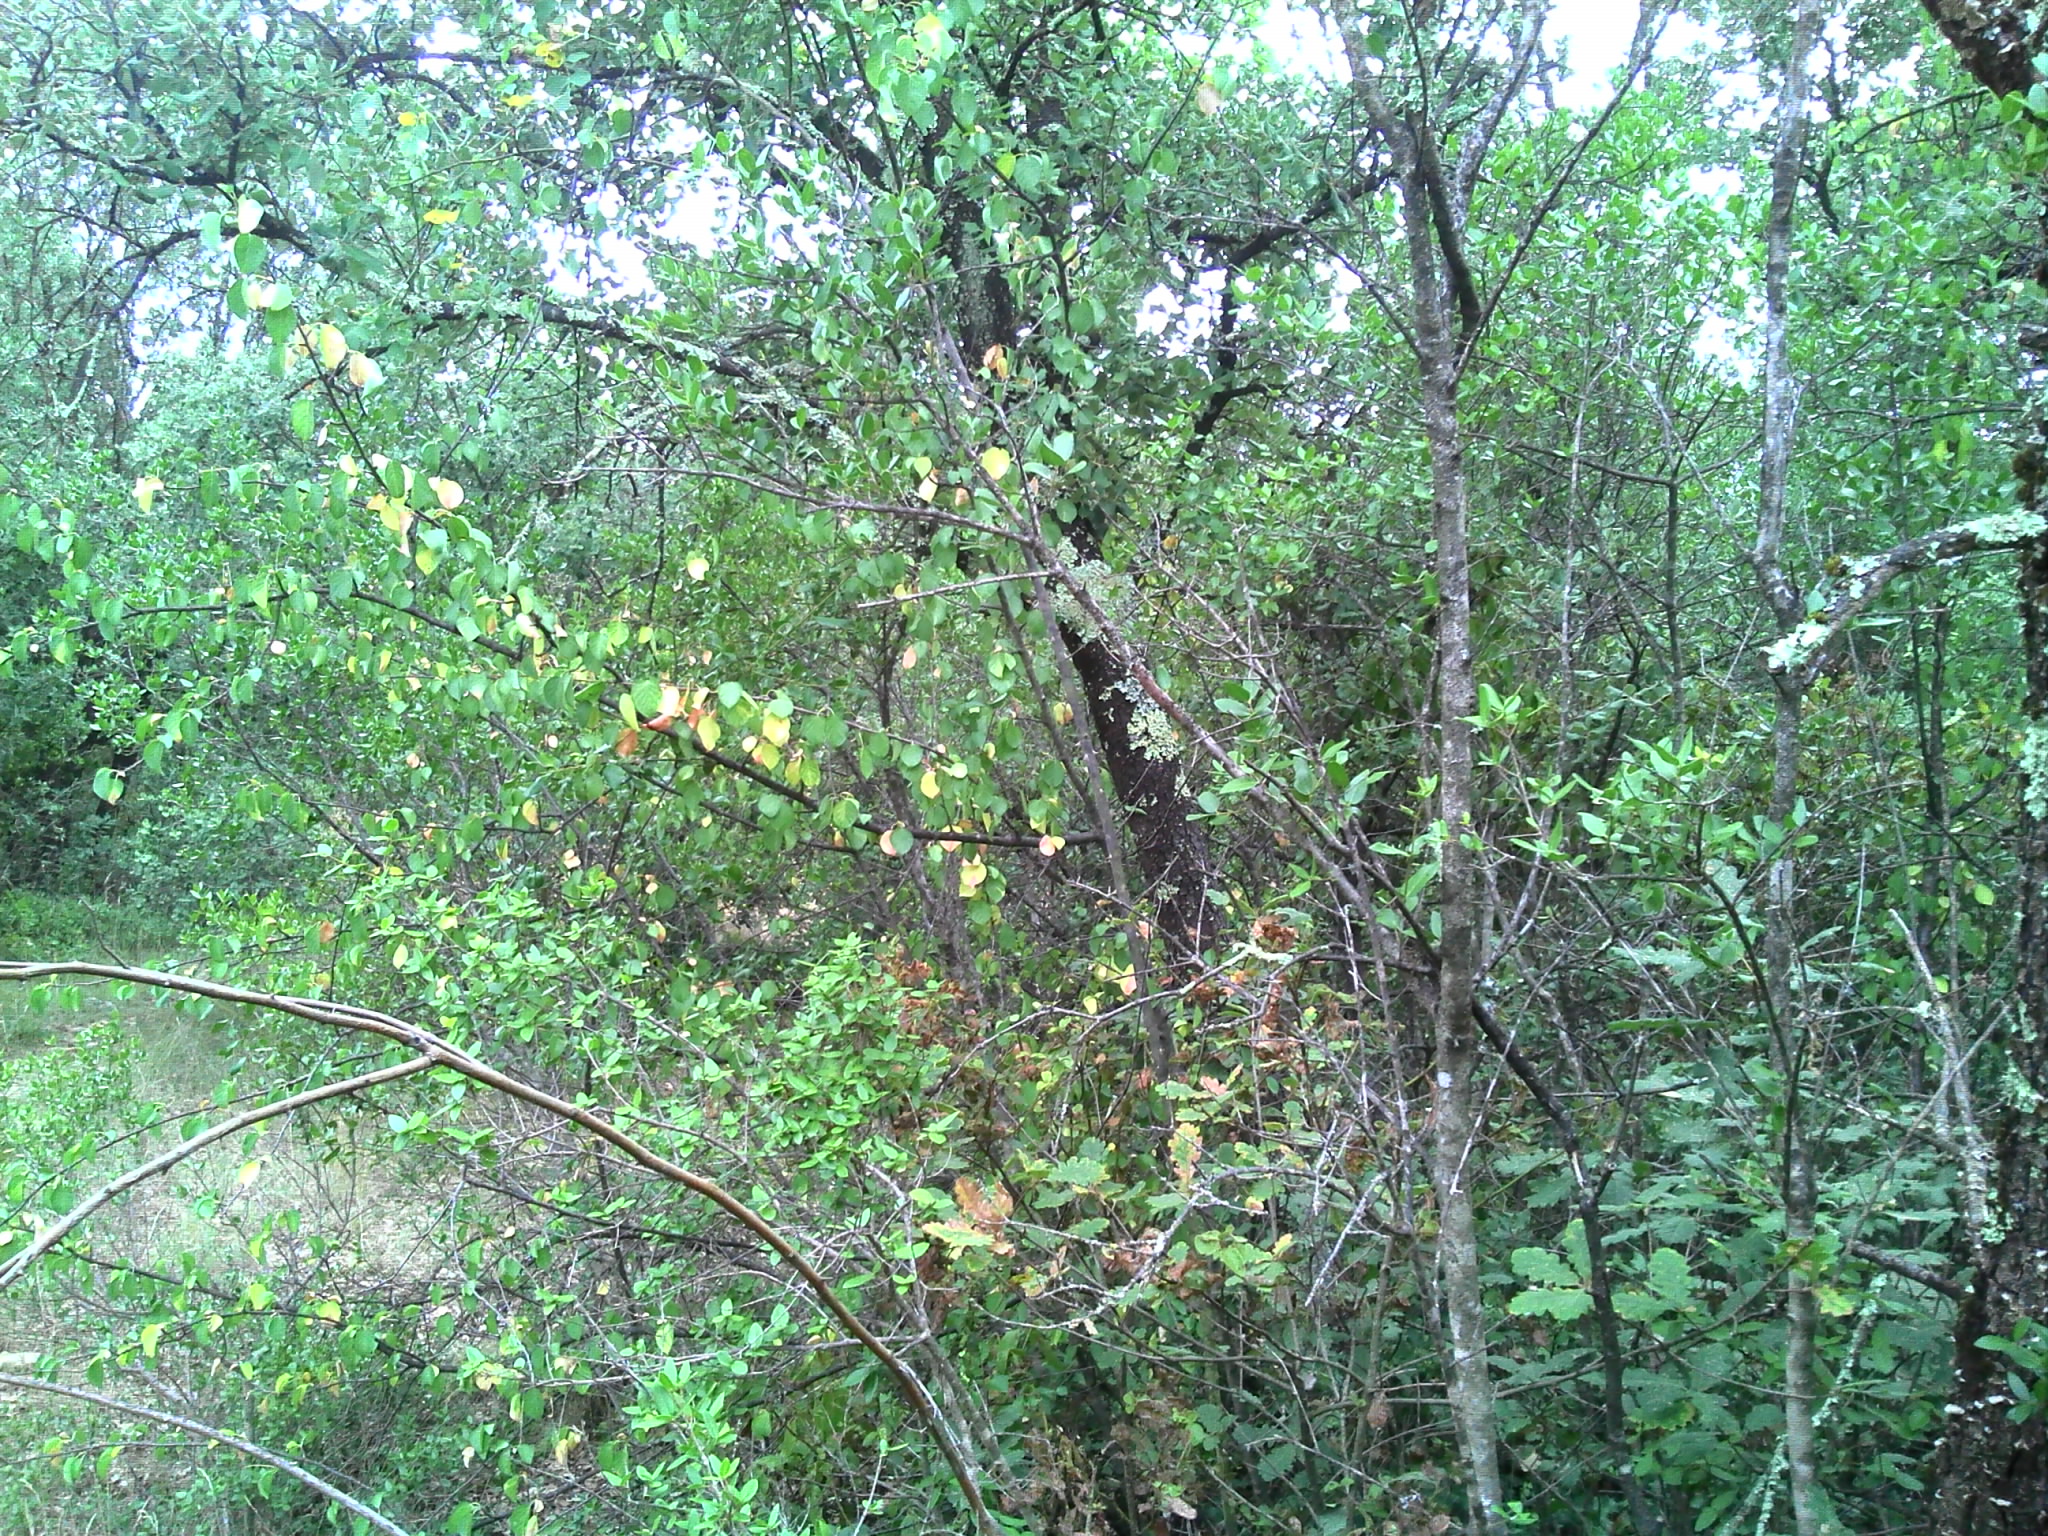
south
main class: Woodland
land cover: Broadleaved woodland
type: broadleaved evergreen forest
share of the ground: > 75 %
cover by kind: broadleaved forest trees 80 %, shrubs 10 %, herbaceous plants 10 %
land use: Semi-natural and natural areas not in use
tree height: > 5 m
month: July
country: FR
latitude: 43.9398
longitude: 3.9658
